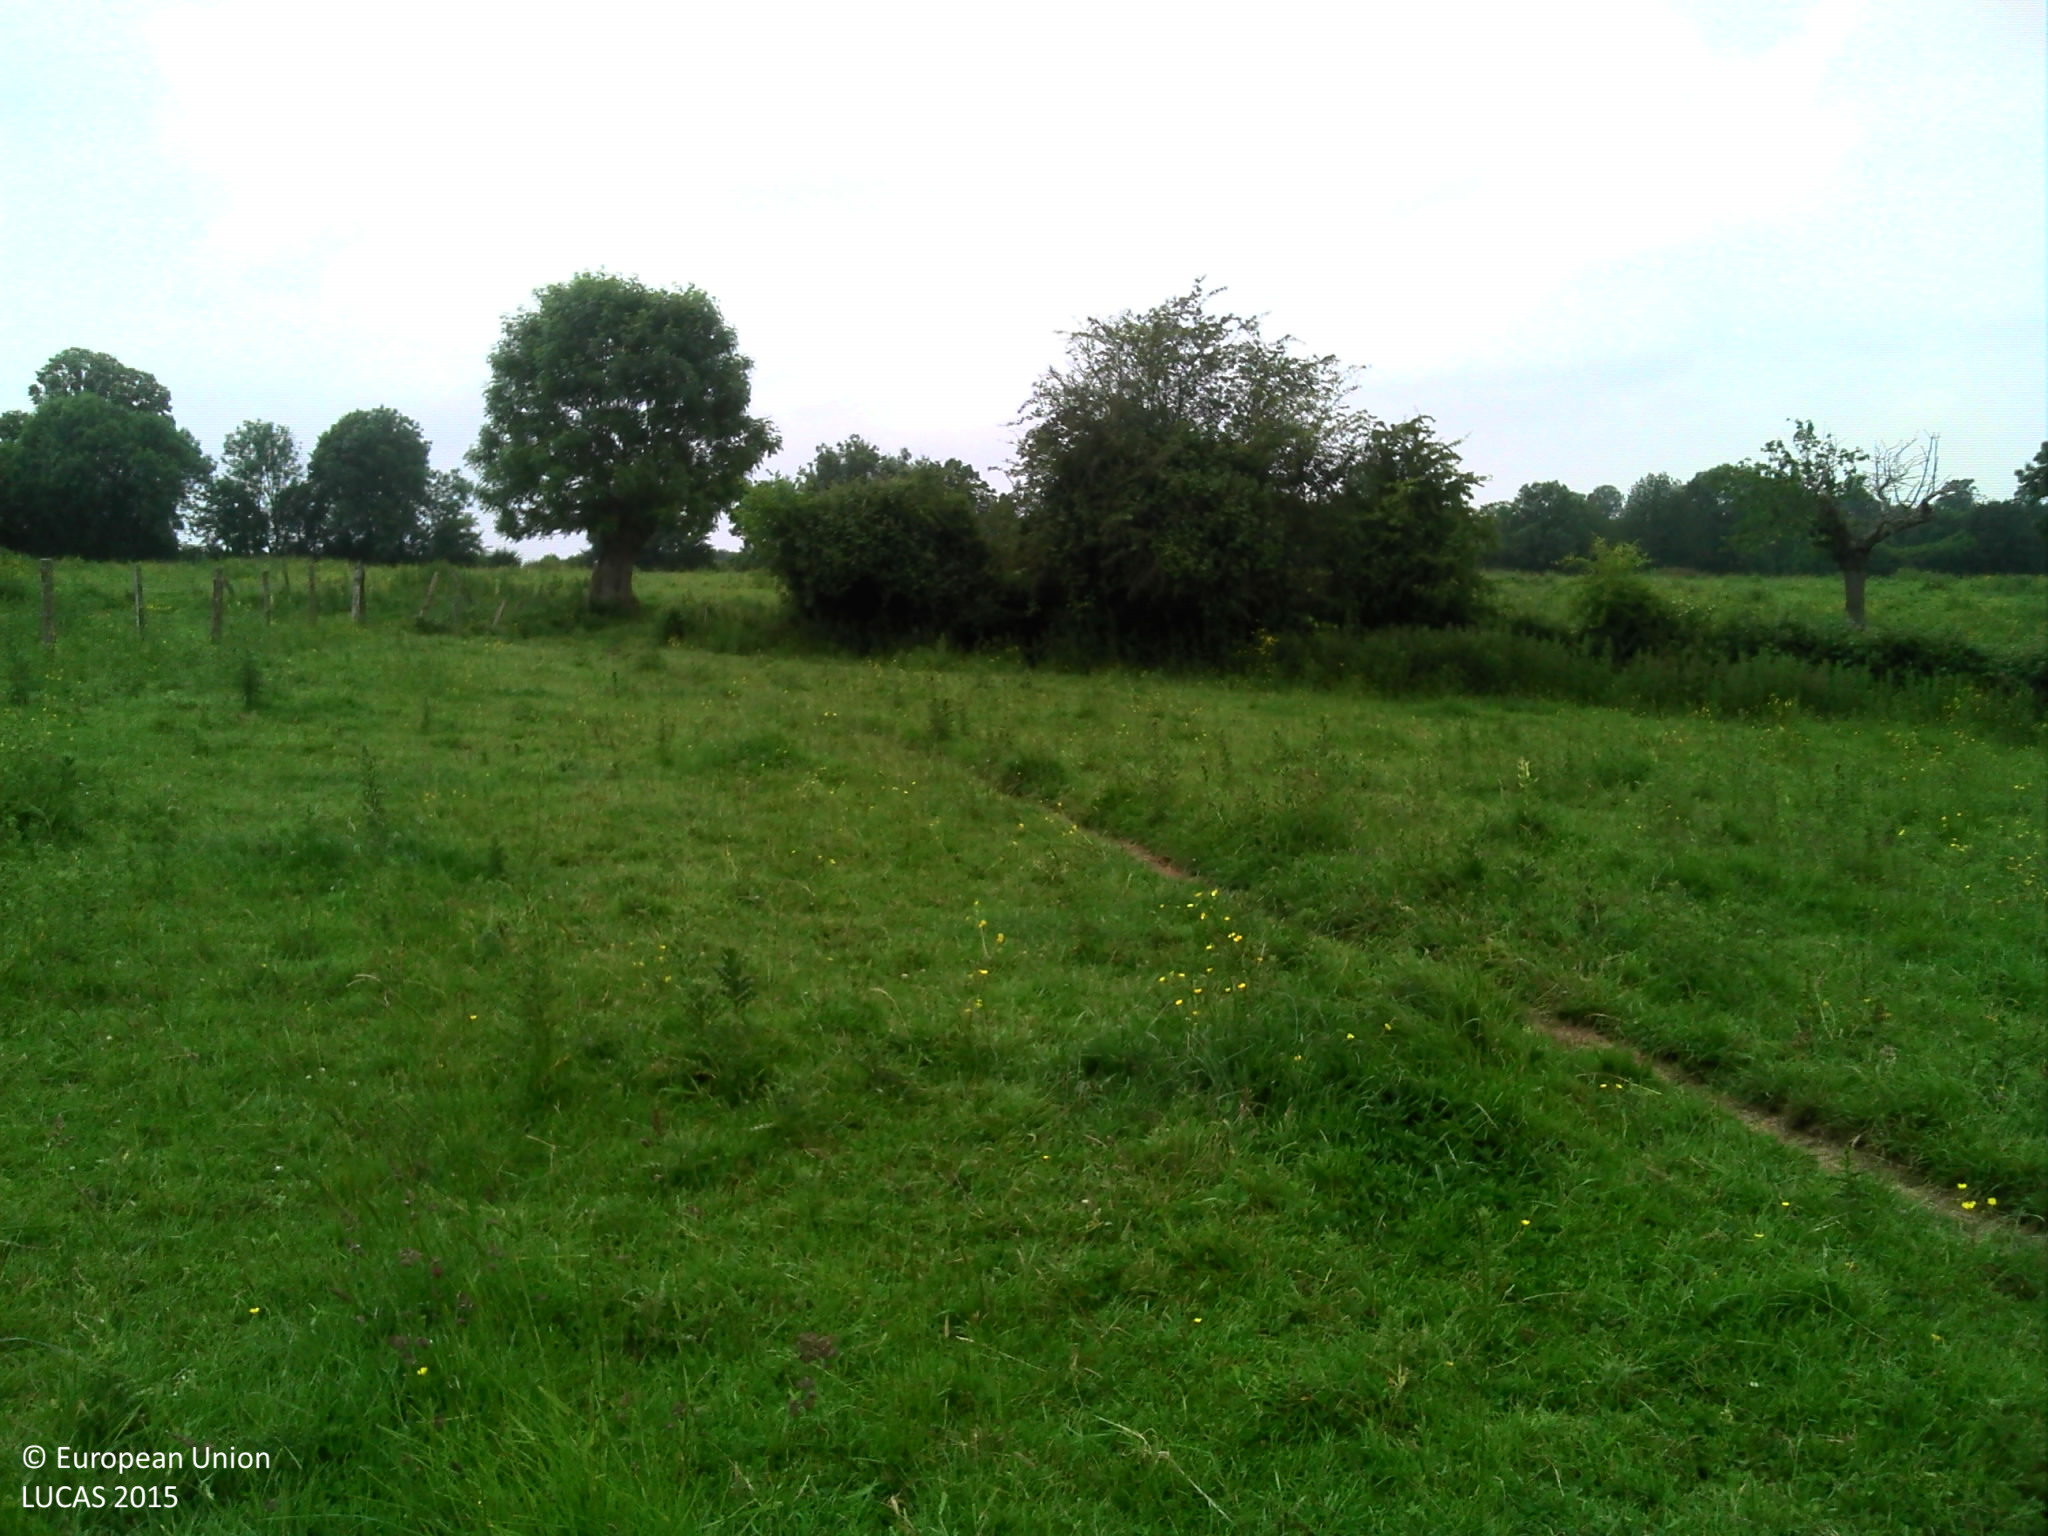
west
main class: Grassland
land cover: Grassland with sparse tree/shrub cover
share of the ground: > 75 %
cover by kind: herbaceous plants 95 %, broadleaved forest trees 5 %
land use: Agriculture (excluding fallow land and kitchen gardens)
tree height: > 5 m
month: June
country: FR
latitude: 49.2193
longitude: 0.0152
